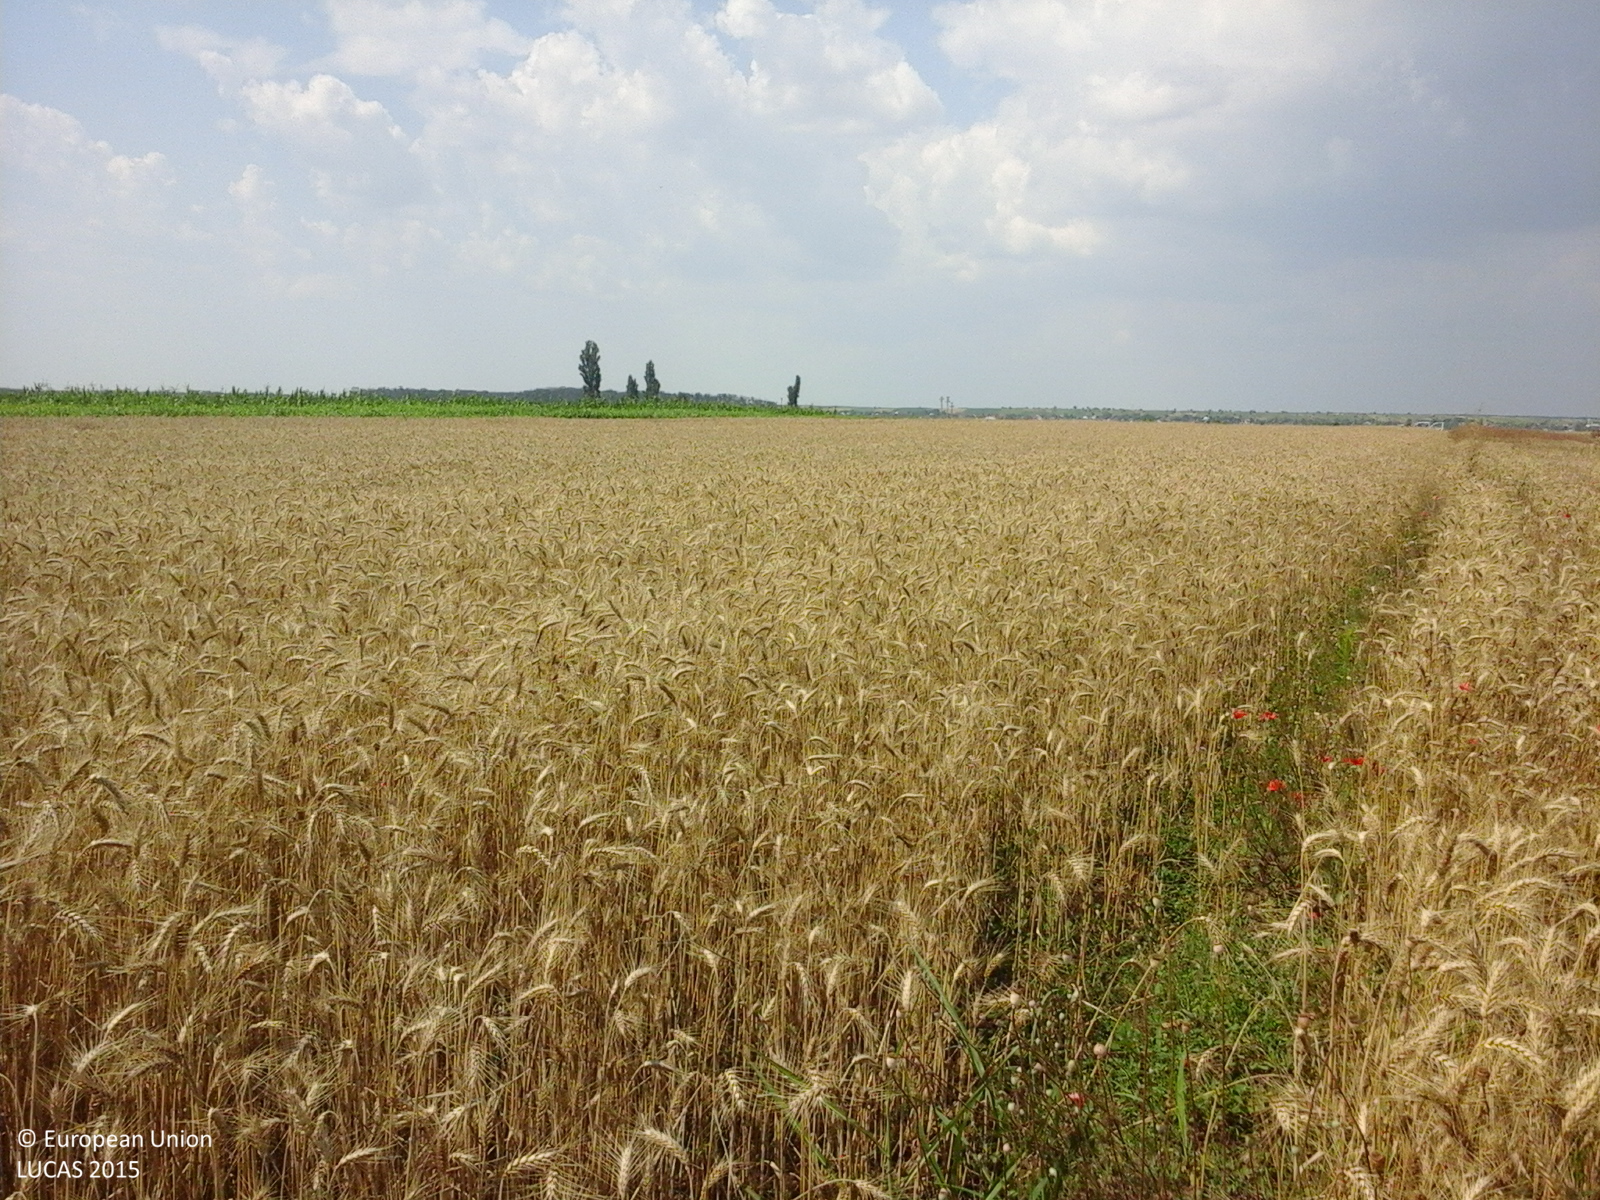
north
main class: Cropland
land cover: Common wheat
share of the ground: > 75 %
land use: Agriculture (excluding fallow land and kitchen gardens)
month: July
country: RO
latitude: 44.0132
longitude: 25.1858
